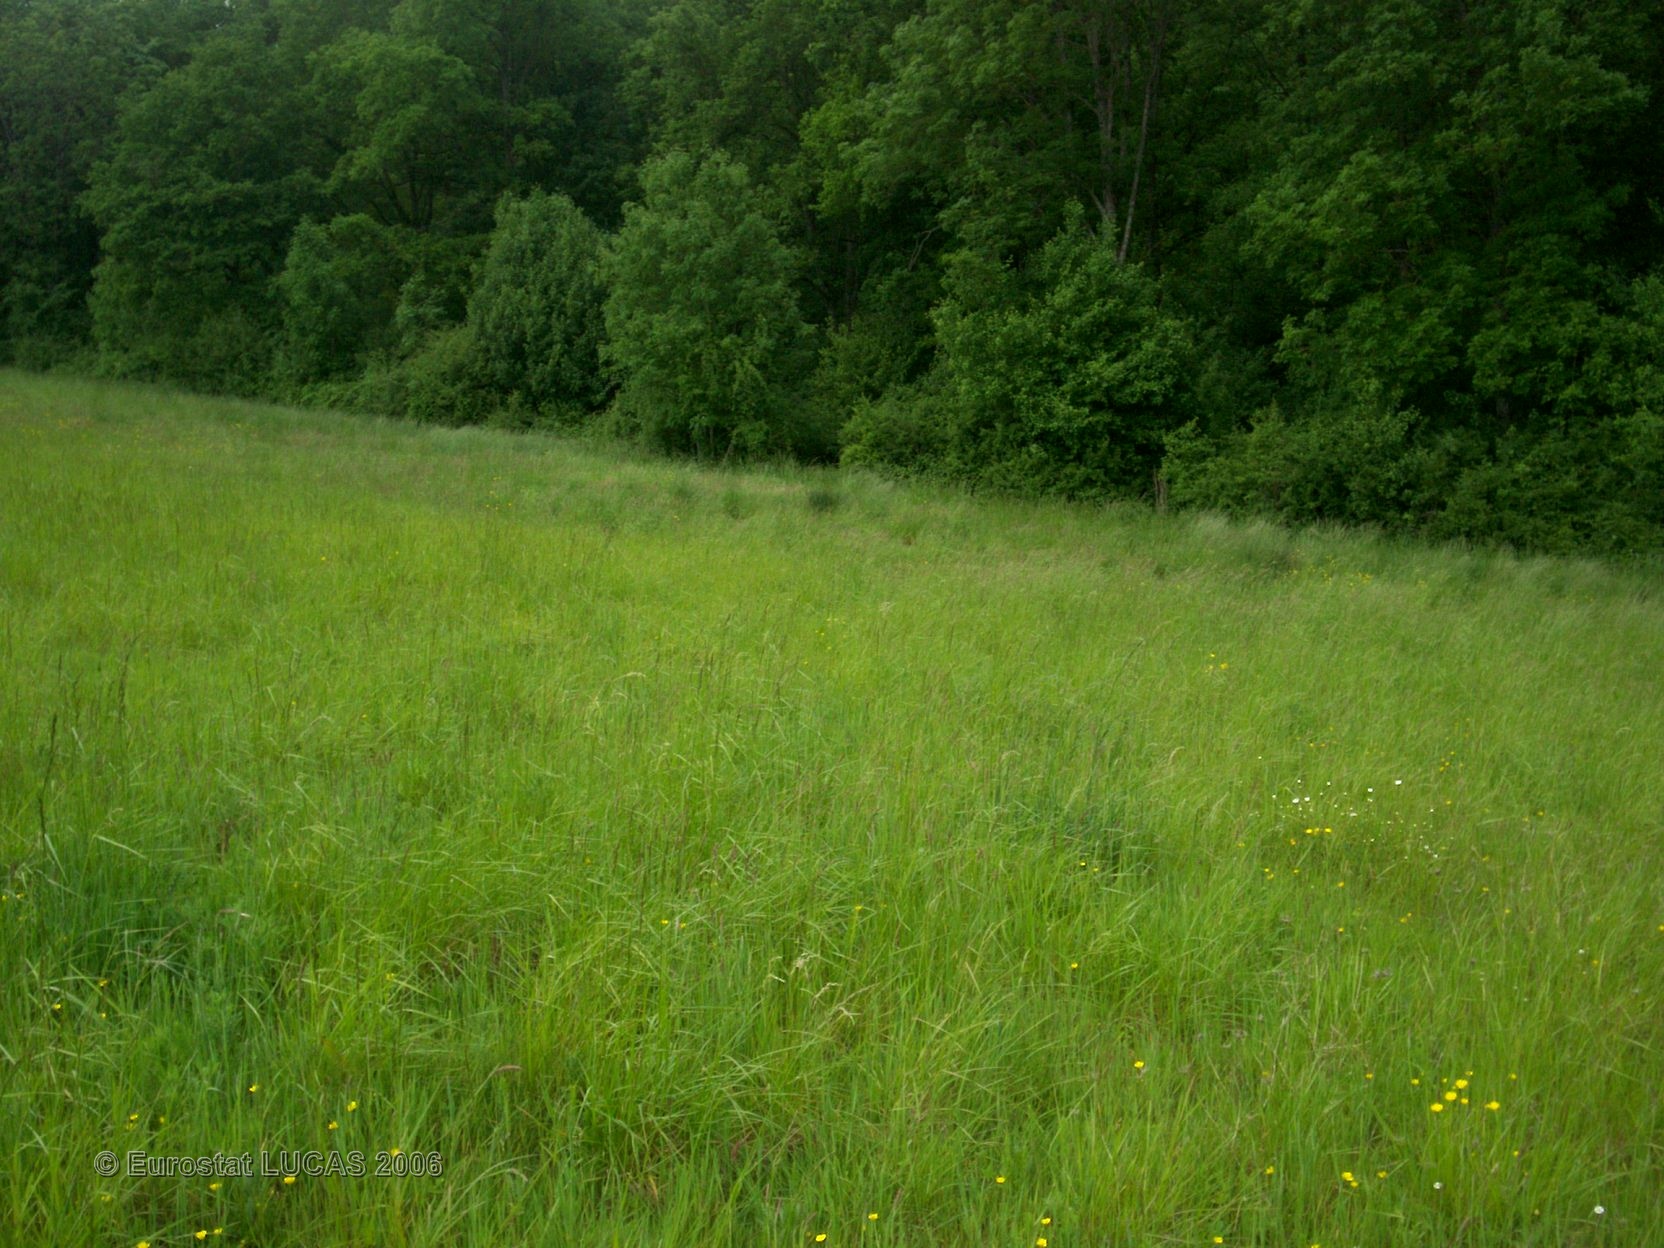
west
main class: Grassland
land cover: Grassland without tree/shrub cover
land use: Agriculture (excluding fallow land and kitchen gardens)
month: May
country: FR
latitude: 48.3291
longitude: 4.6700
